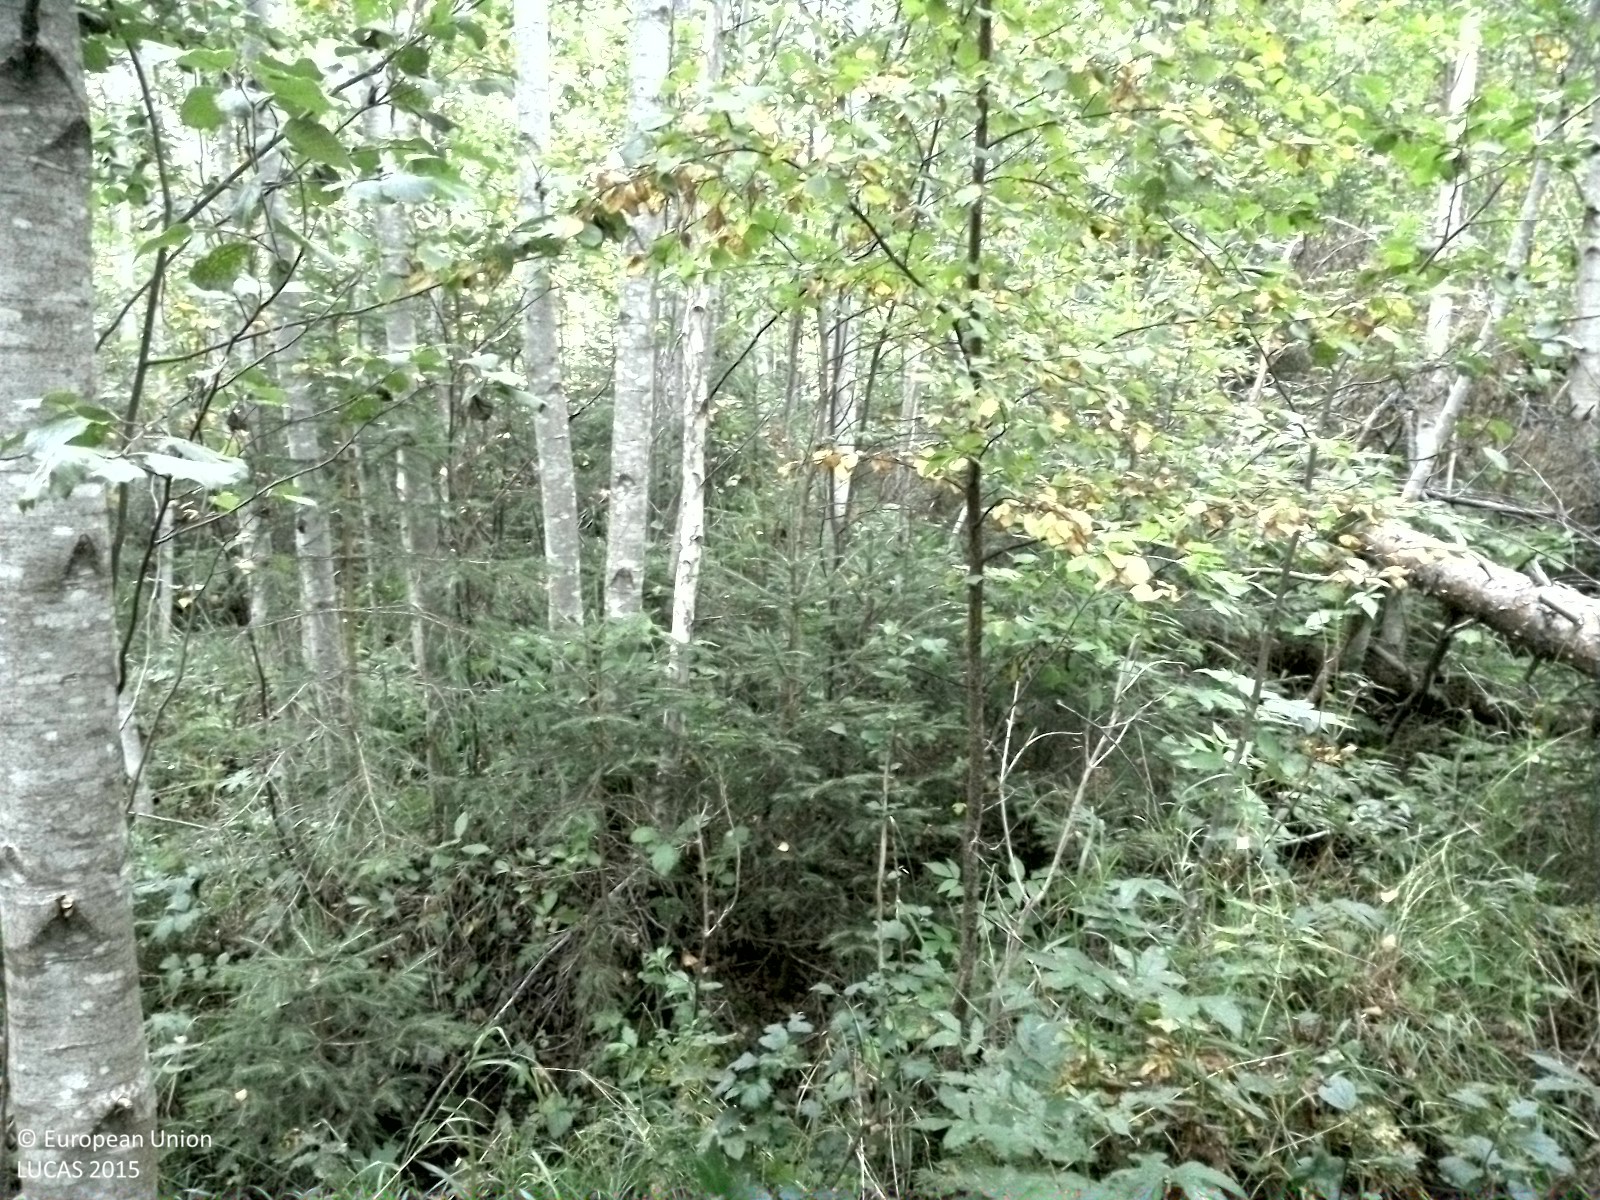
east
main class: Woodland
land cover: Spruce dominated mixed woodland
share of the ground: > 75 %
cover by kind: broadleaved forest trees 45 %, coniferous forest trees 30 %, herbaceous plants 25 %
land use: Forestry
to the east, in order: Spruce dominated mixed woodland; Broadleaved woodland; Grassland with sparse tree/shrub cover; Tracks; Grassland with sparse tree/shrub cover; Other mixed woodland; Other bare soil
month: September
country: SE
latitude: 62.4648
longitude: 16.2422
